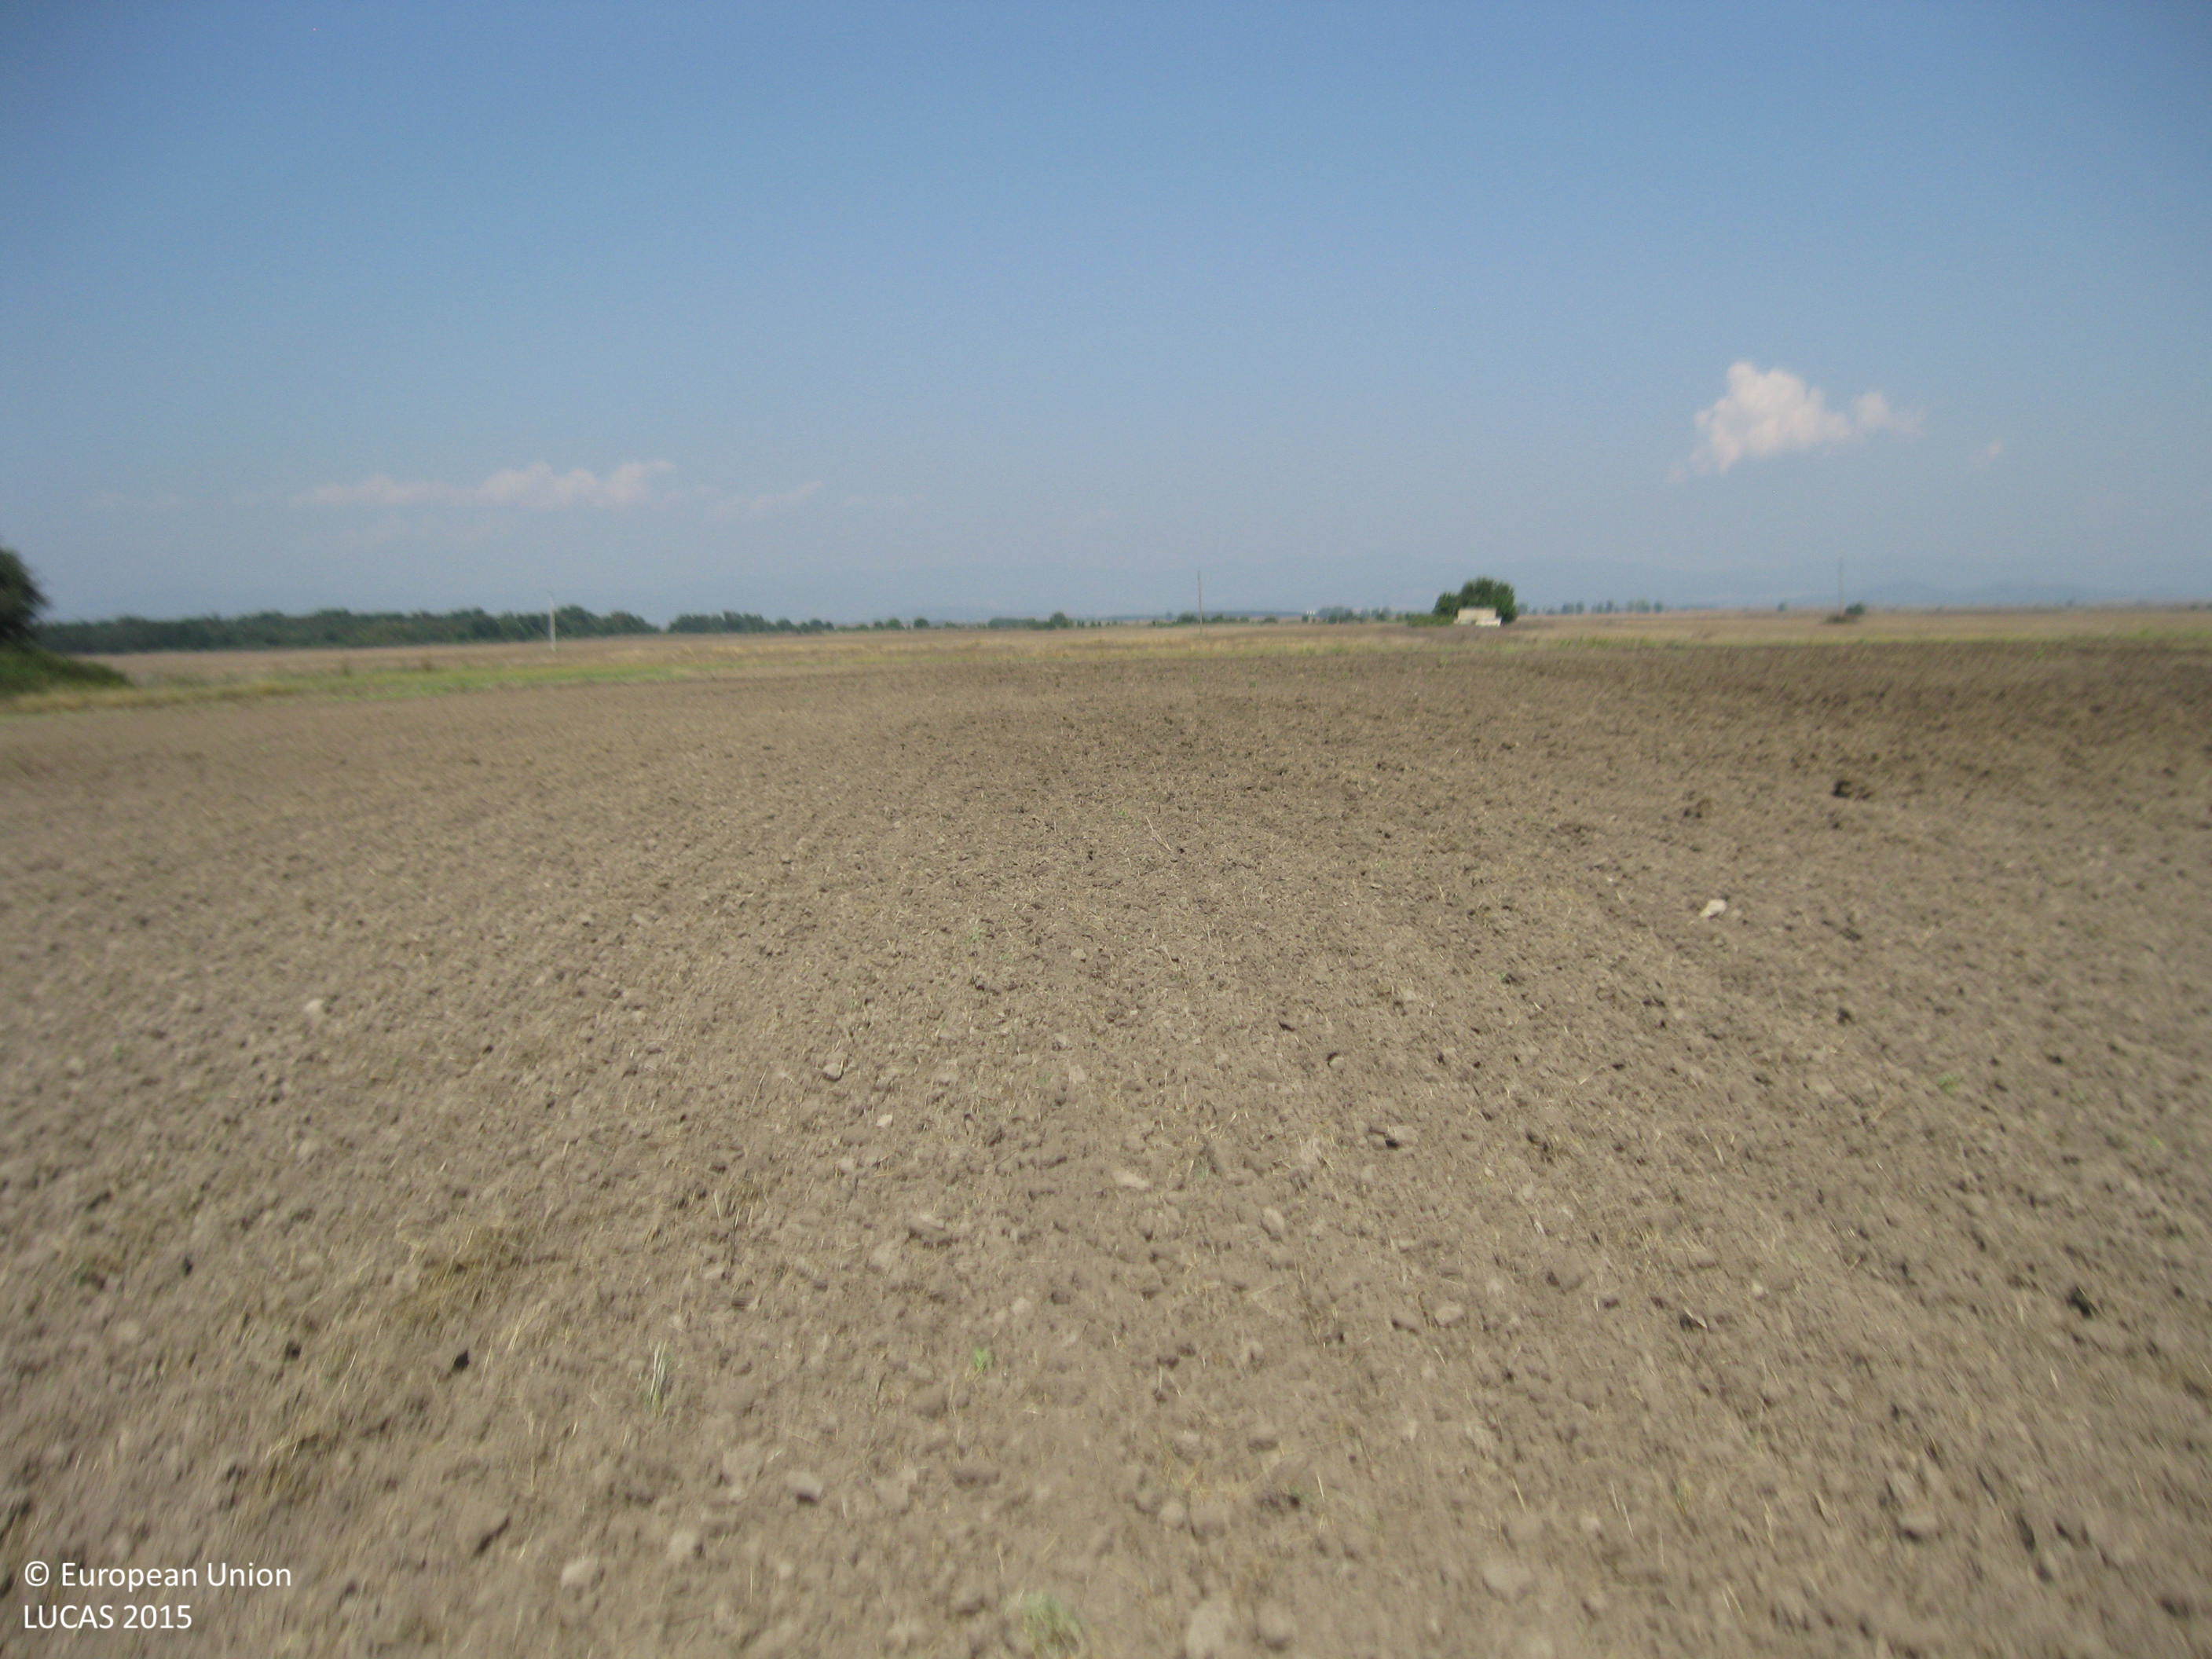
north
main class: Cropland
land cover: Common wheat
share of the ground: < 10 %
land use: Agriculture (excluding fallow land and kitchen gardens)
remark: Harvested field
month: September
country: BG
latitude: 42.2412
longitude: 25.0242
